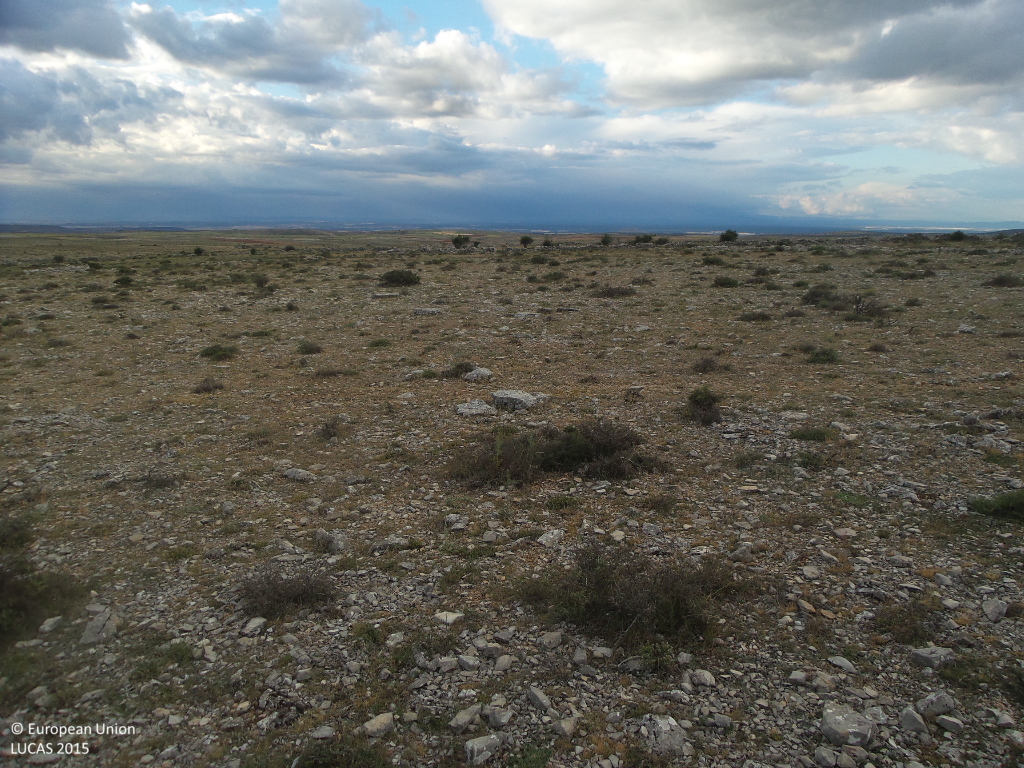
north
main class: Shrubland
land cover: Shrubland without tree cover
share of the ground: 25 - 50 %
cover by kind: unconsolidated bare surface 60 %, shrubs 20 %, herbaceous plants 20 %
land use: Semi-natural and natural areas not in use
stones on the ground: > 50 %
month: June
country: ES
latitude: 41.3659
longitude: -3.0595
